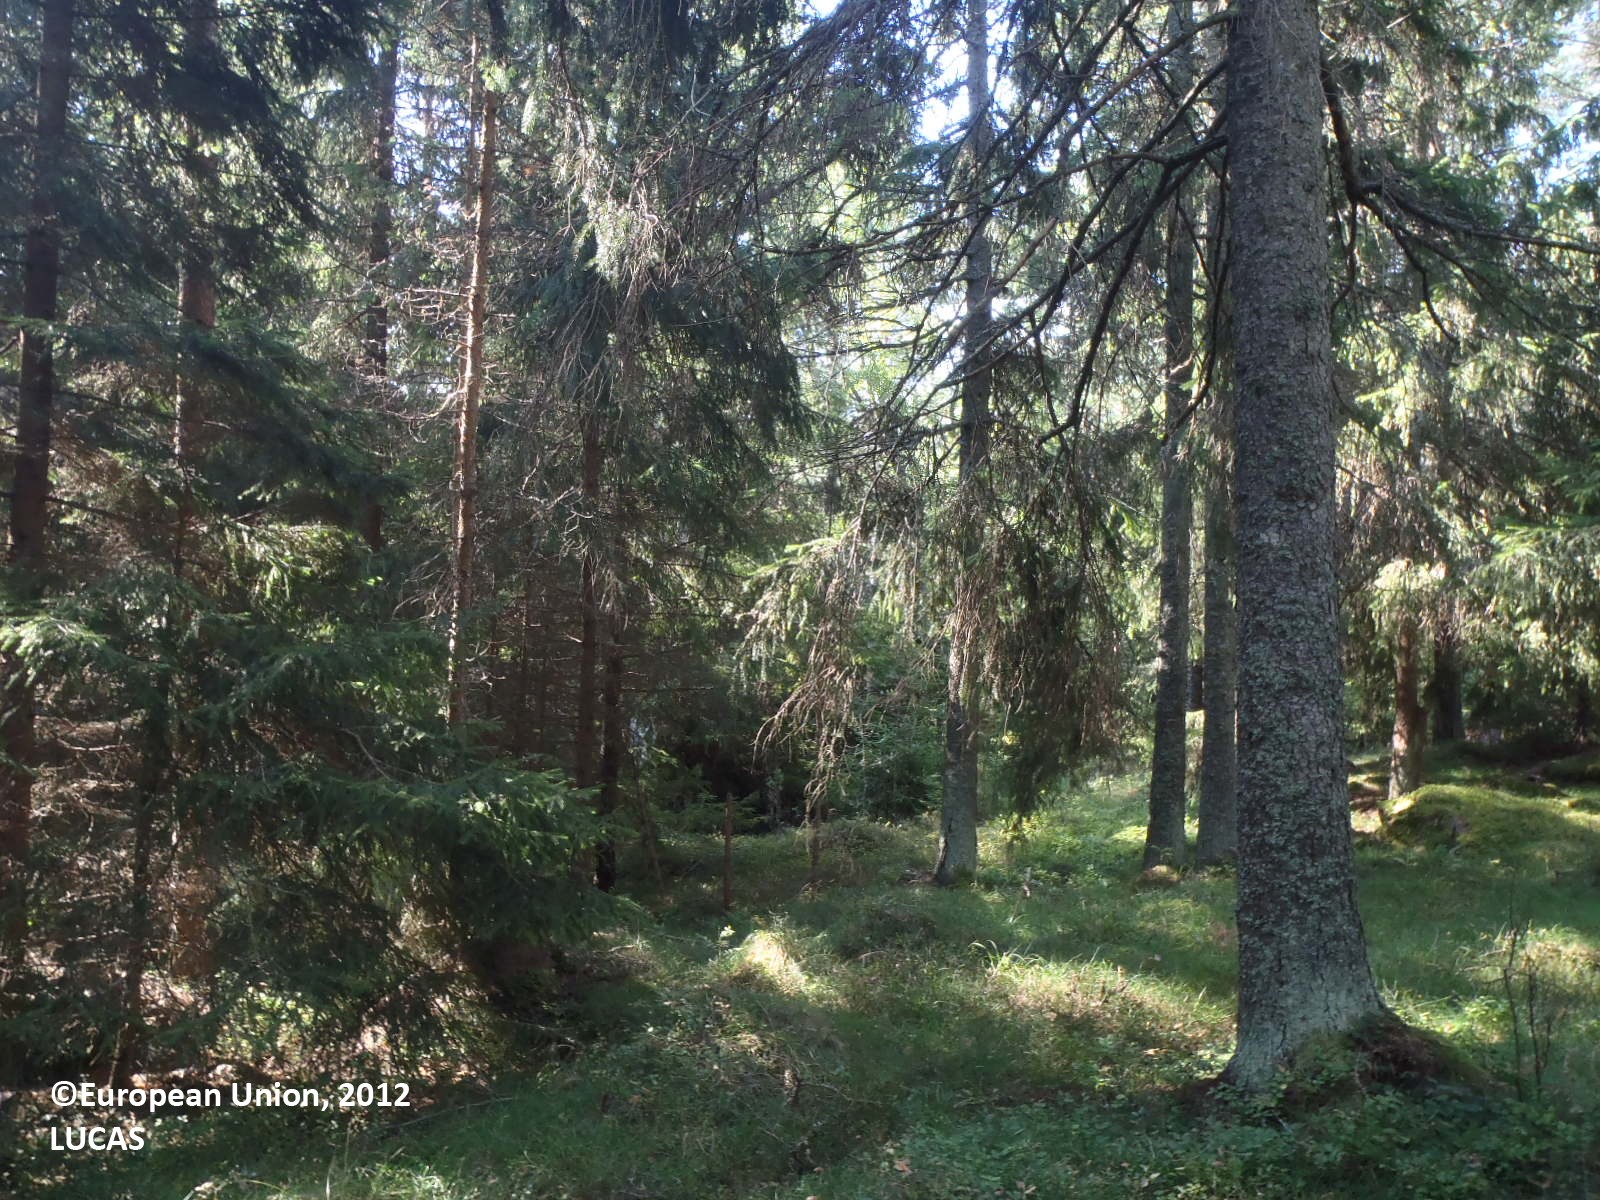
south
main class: Woodland
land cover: Pine dominated coniferous woodland
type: hemiboreal forest and nemoral coniferous forest and mixed broadleaved-coniferous forest
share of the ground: > 75 %
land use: Forestry
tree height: > 5 m
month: August
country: FI
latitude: 60.3622
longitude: 20.1044
